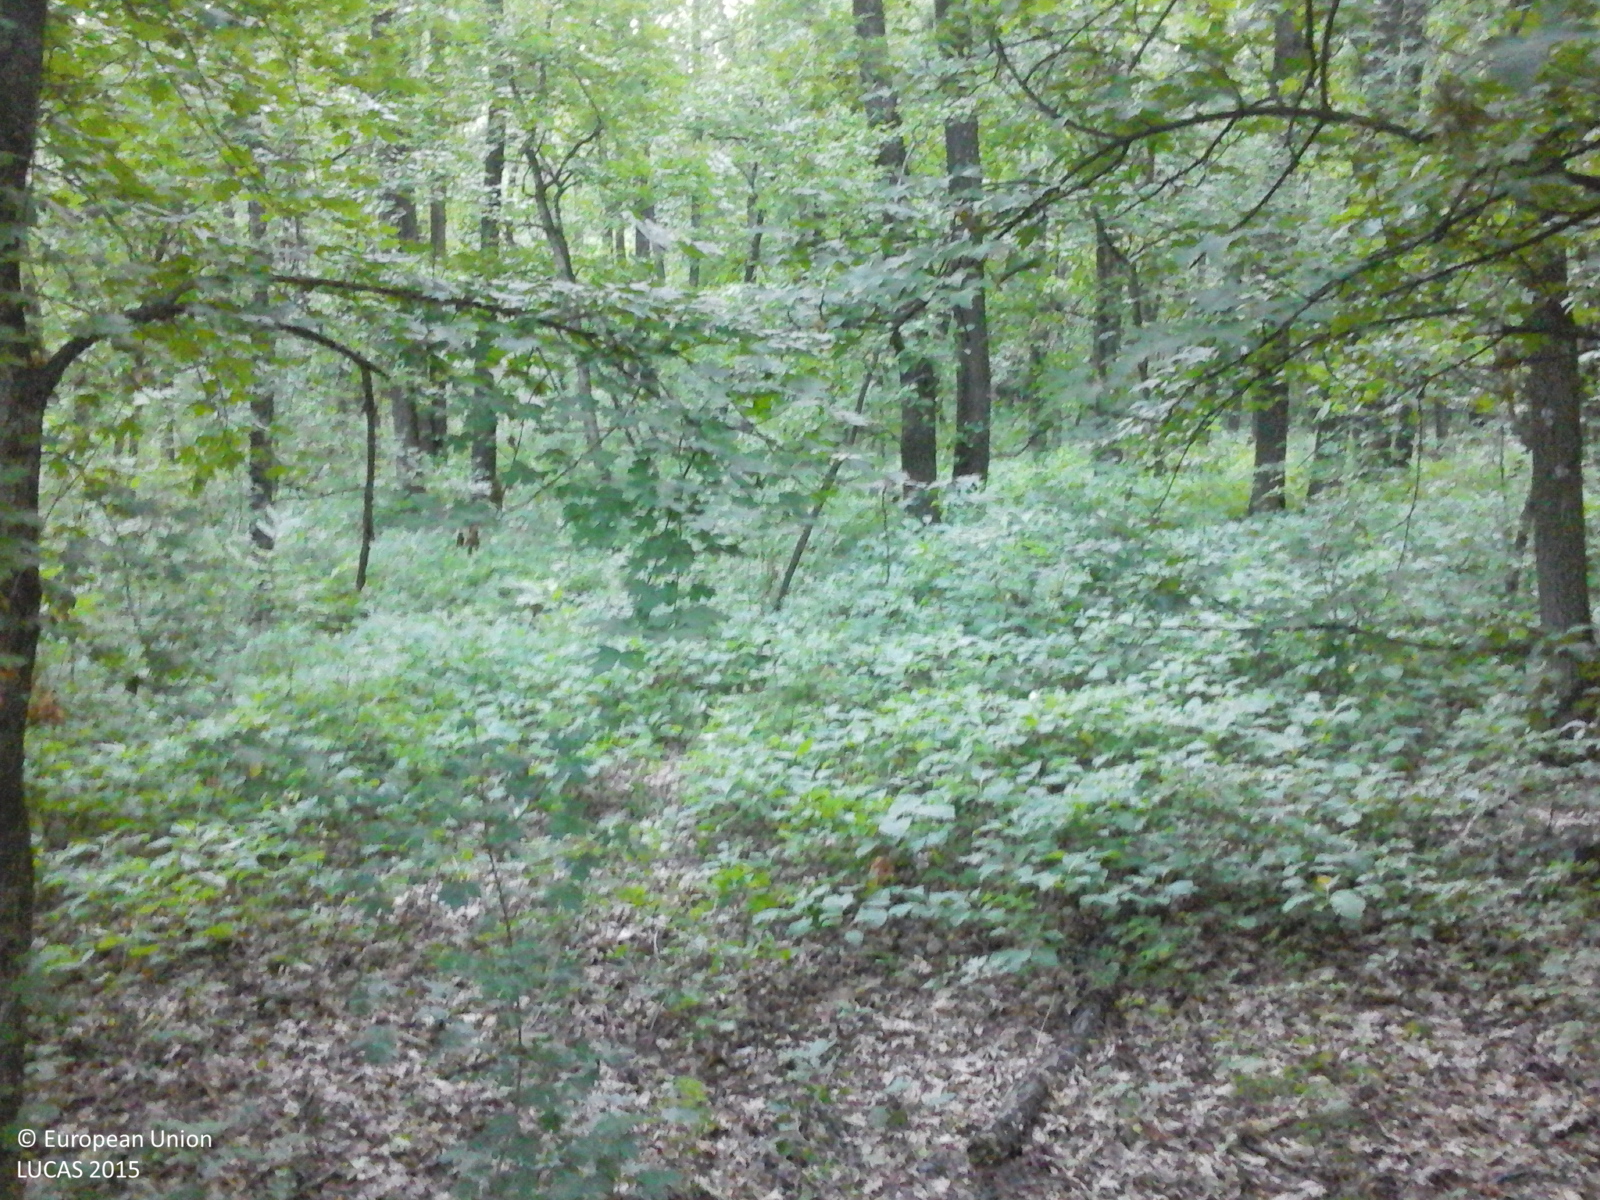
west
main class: Woodland
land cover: Broadleaved woodland
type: mesophytic deciduous forest
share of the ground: > 75 %
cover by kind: broadleaved forest trees 95 %, herbaceous plants 5 %
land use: Forestry
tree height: > 5 m
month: June
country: RO
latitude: 47.6247
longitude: 27.2367
